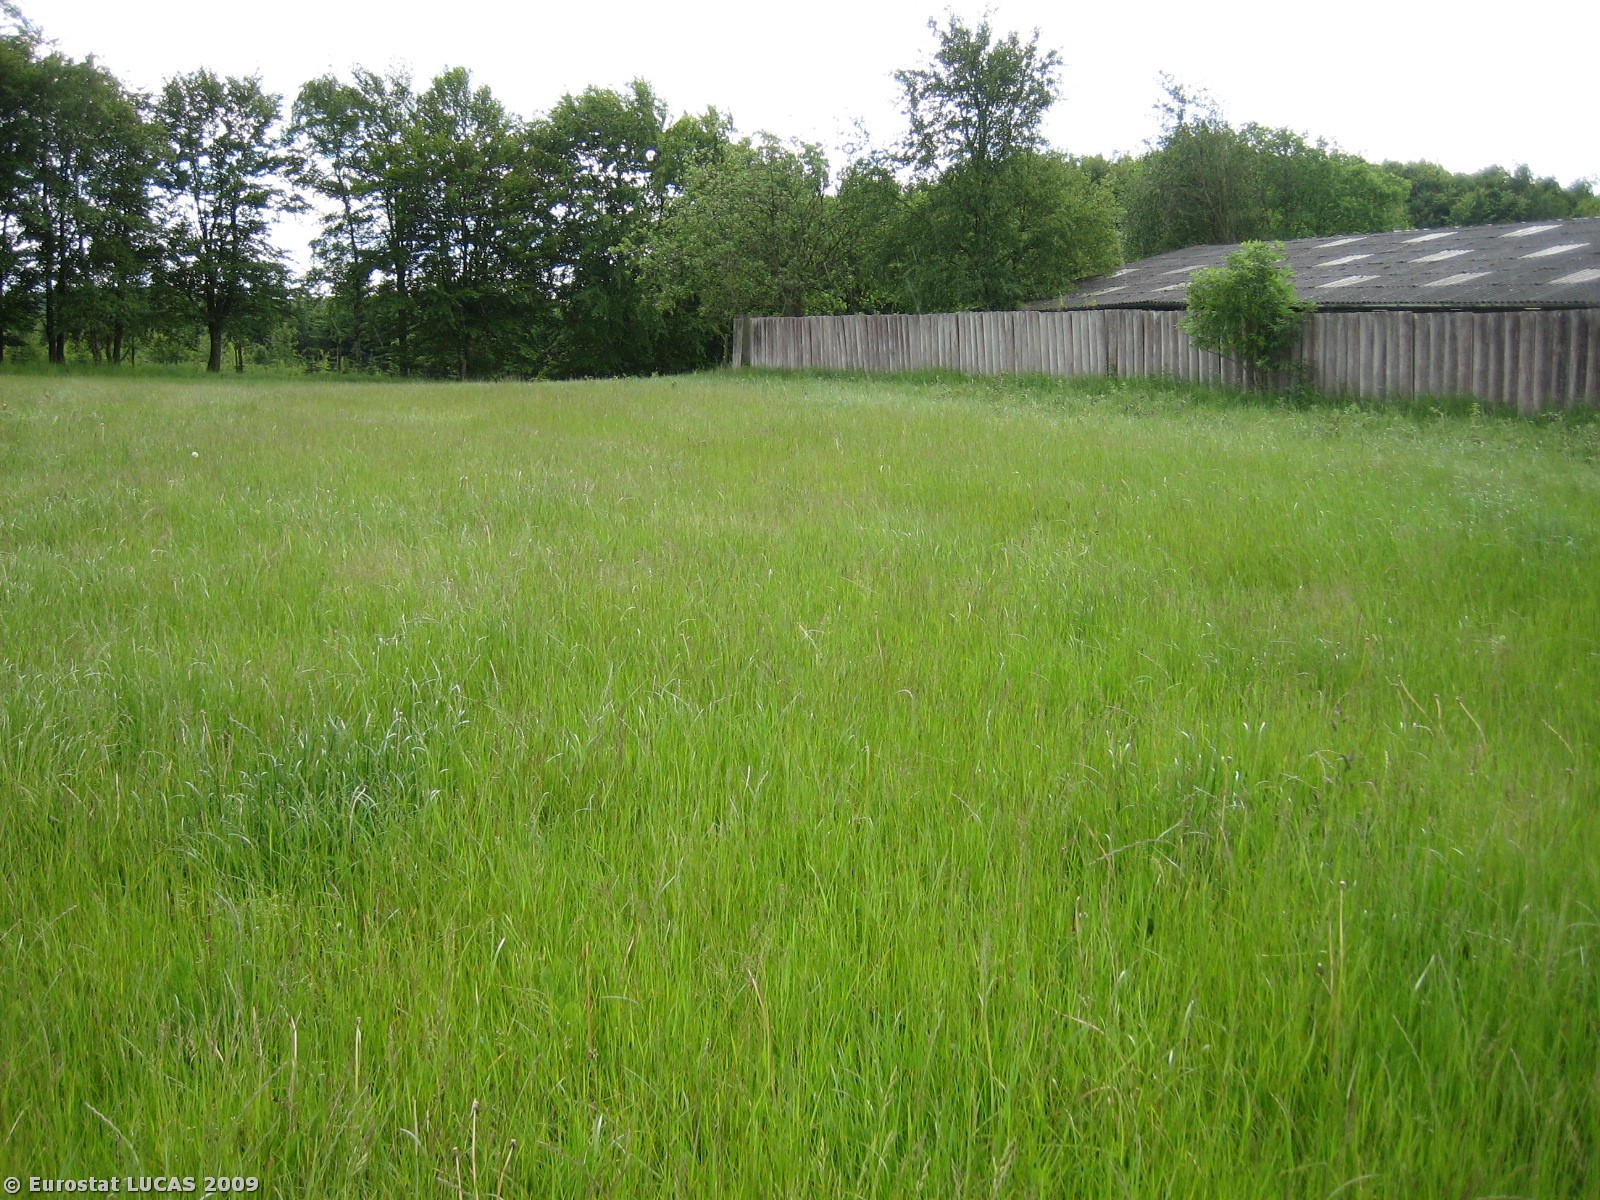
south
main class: Grassland
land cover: Grassland without tree/shrub cover
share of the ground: > 75 %
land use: Agriculture (excluding fallow land and kitchen gardens)
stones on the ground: < 10 %
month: June
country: DK
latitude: 56.2775
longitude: 9.8548
